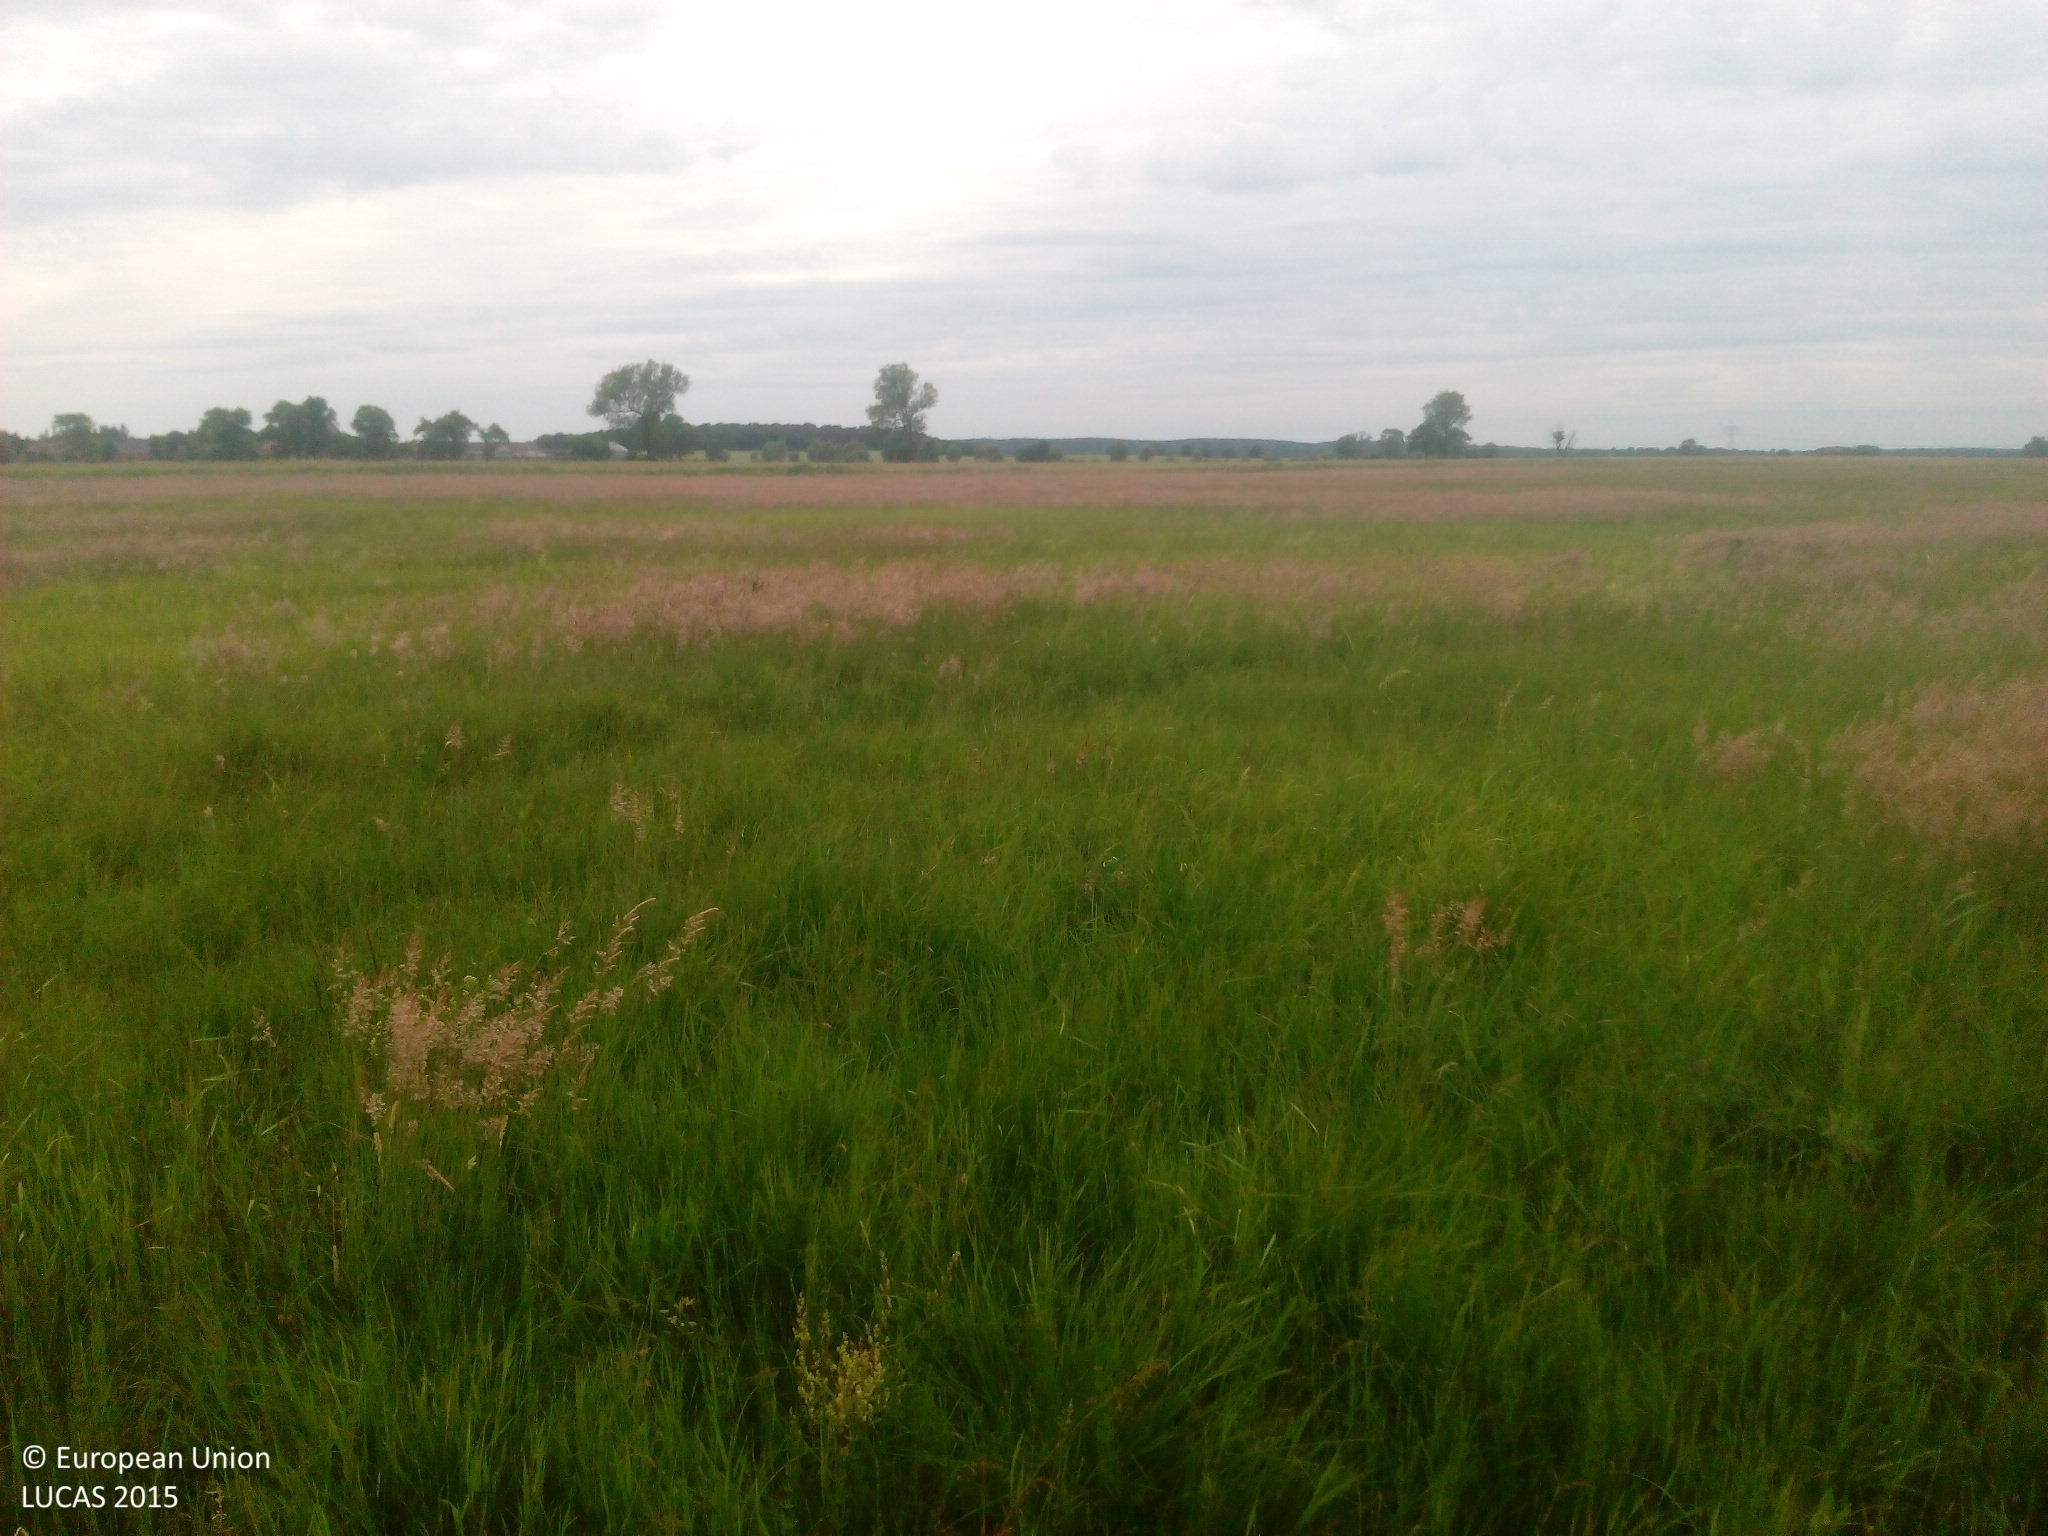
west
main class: Grassland
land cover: Grassland without tree/shrub cover
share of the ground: > 75 %
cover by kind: herbaceous plants 100 %
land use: Semi-natural and natural areas not in use
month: June
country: DE
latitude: 52.6191
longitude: 12.5845
